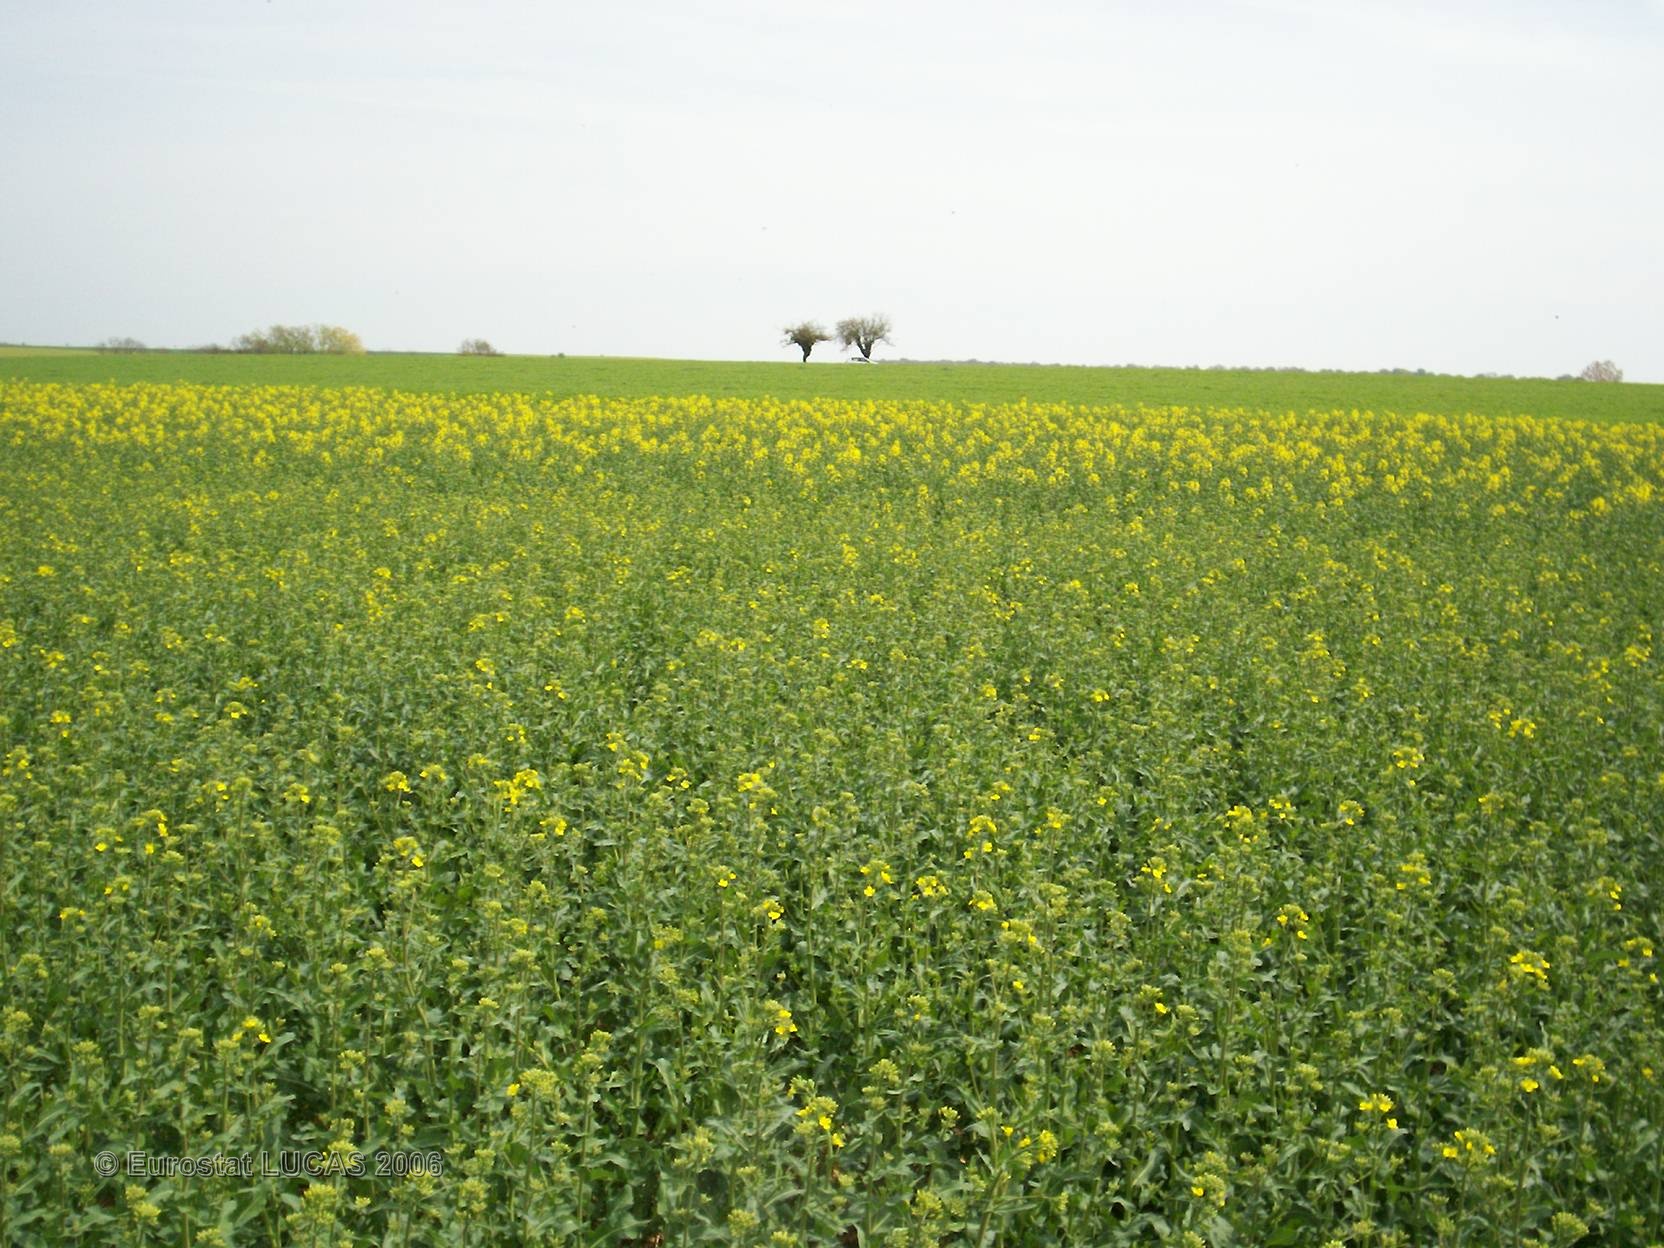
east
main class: Cropland
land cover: Rape and turnip rape
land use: Agriculture (excluding fallow land and kitchen gardens)
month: May
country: FR
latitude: 47.6215
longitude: 4.5835
